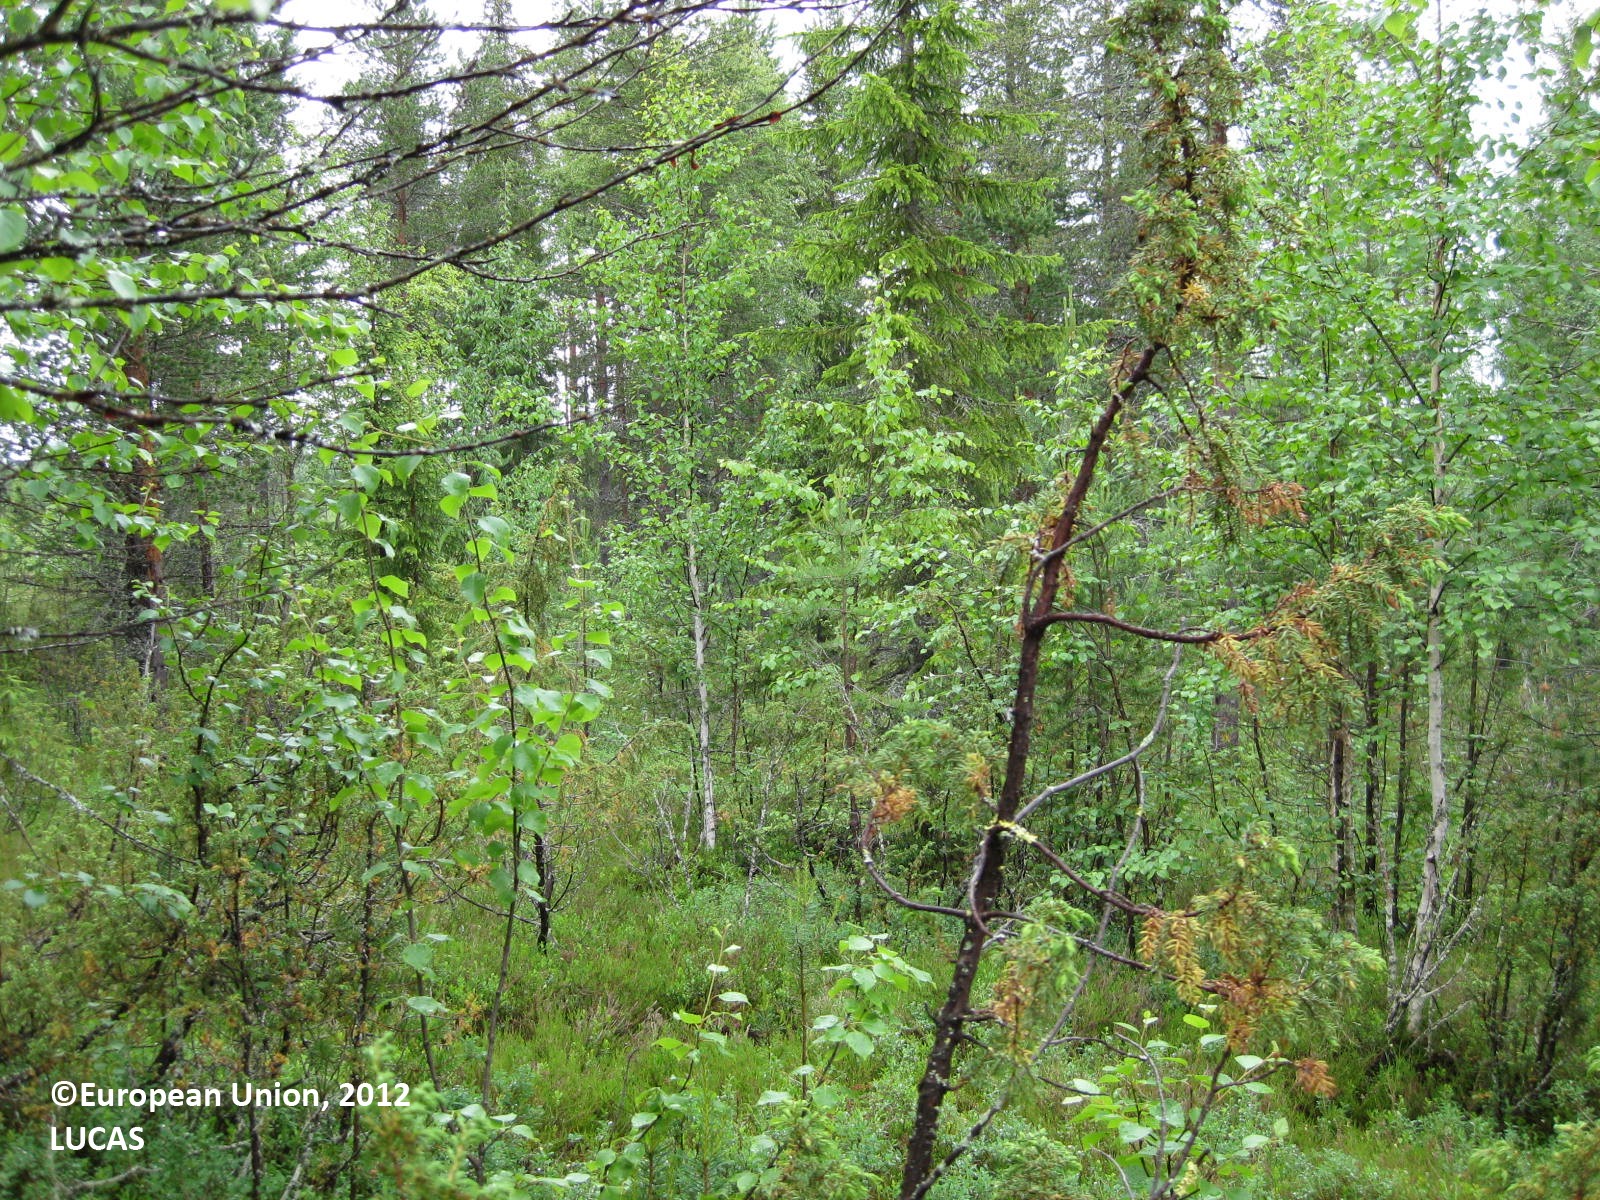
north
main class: Woodland
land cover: Pine dominated mixed woodland
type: boreal forest
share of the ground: > 75 %
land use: Forestry
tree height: > 5 m
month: July
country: FI
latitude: 65.4577
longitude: 28.2118
